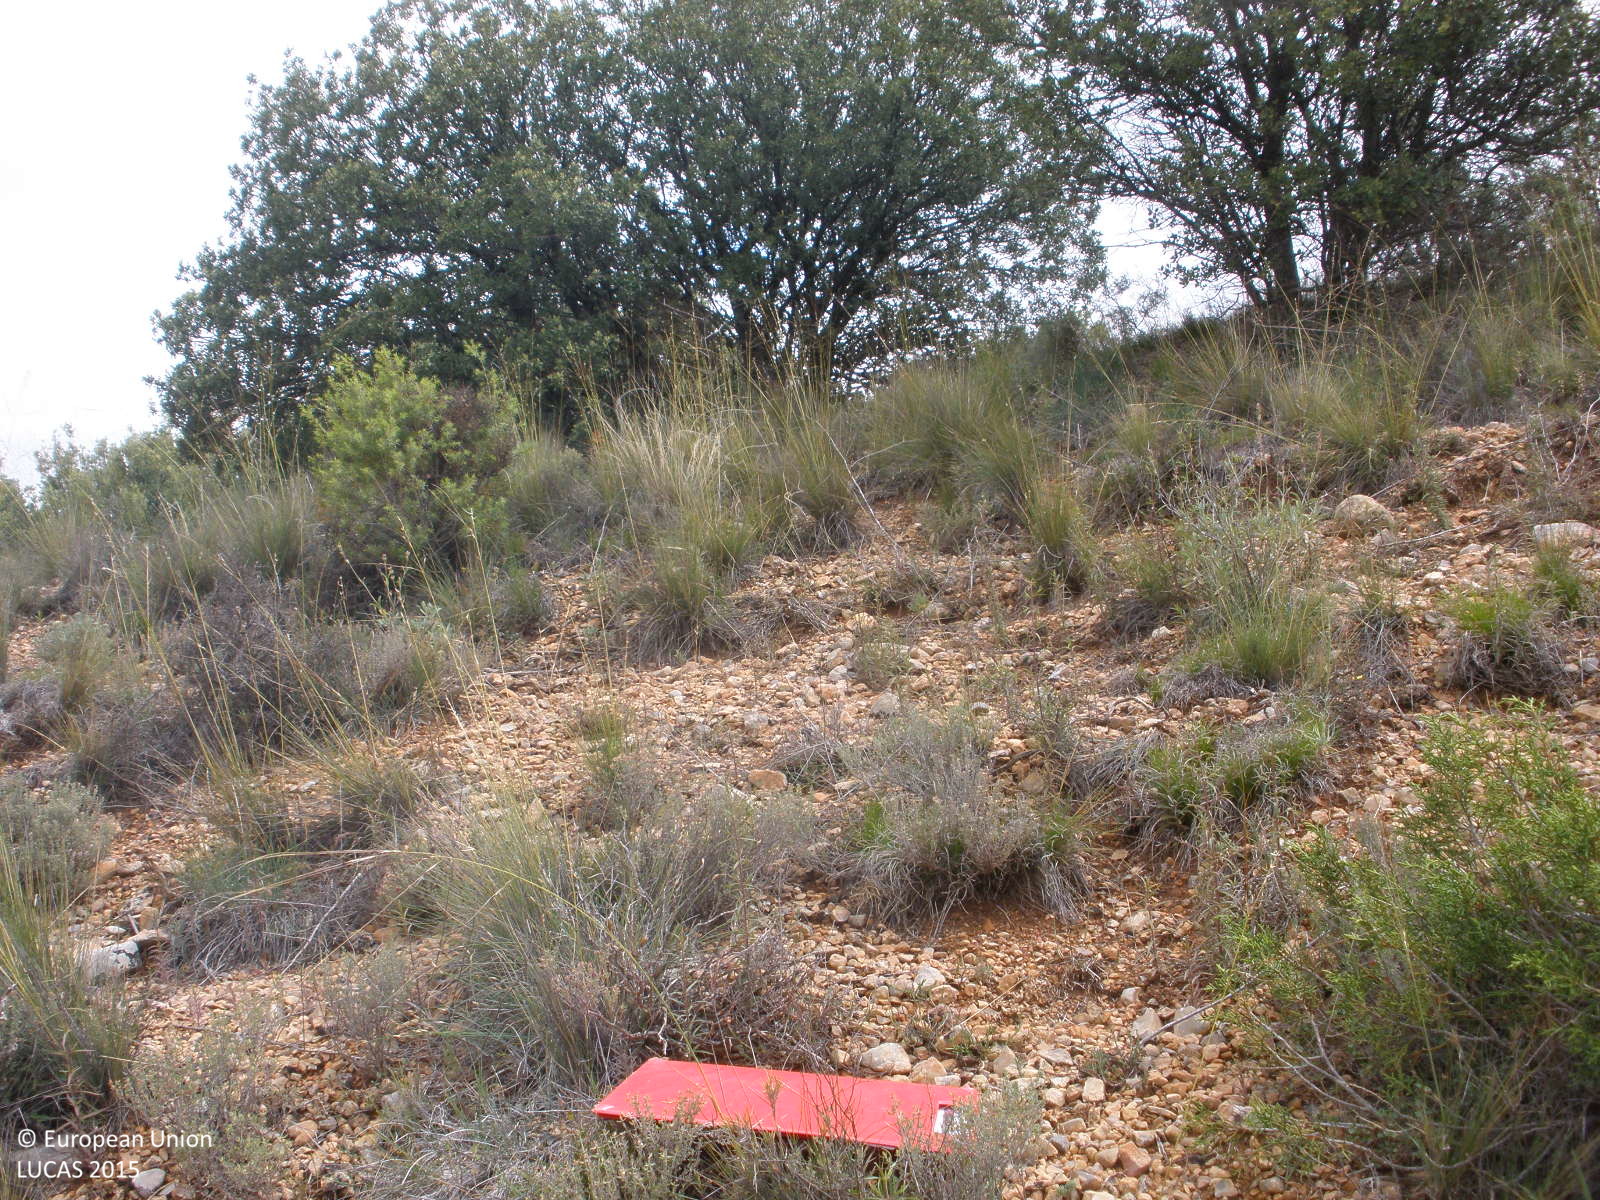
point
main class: Woodland
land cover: Other mixed woodland
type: coniferous forest of the mediterranean region
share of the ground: 25 - 50 %
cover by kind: shrubs 30 %, coniferous forest trees 20 %, broadleaved forest trees 20 %, consolidated bare surface 20 %, herbaceous plants 10 %
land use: Semi-natural and natural areas not in use
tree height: < 5 m
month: June
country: ES
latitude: 40.4660
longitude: -1.0149
